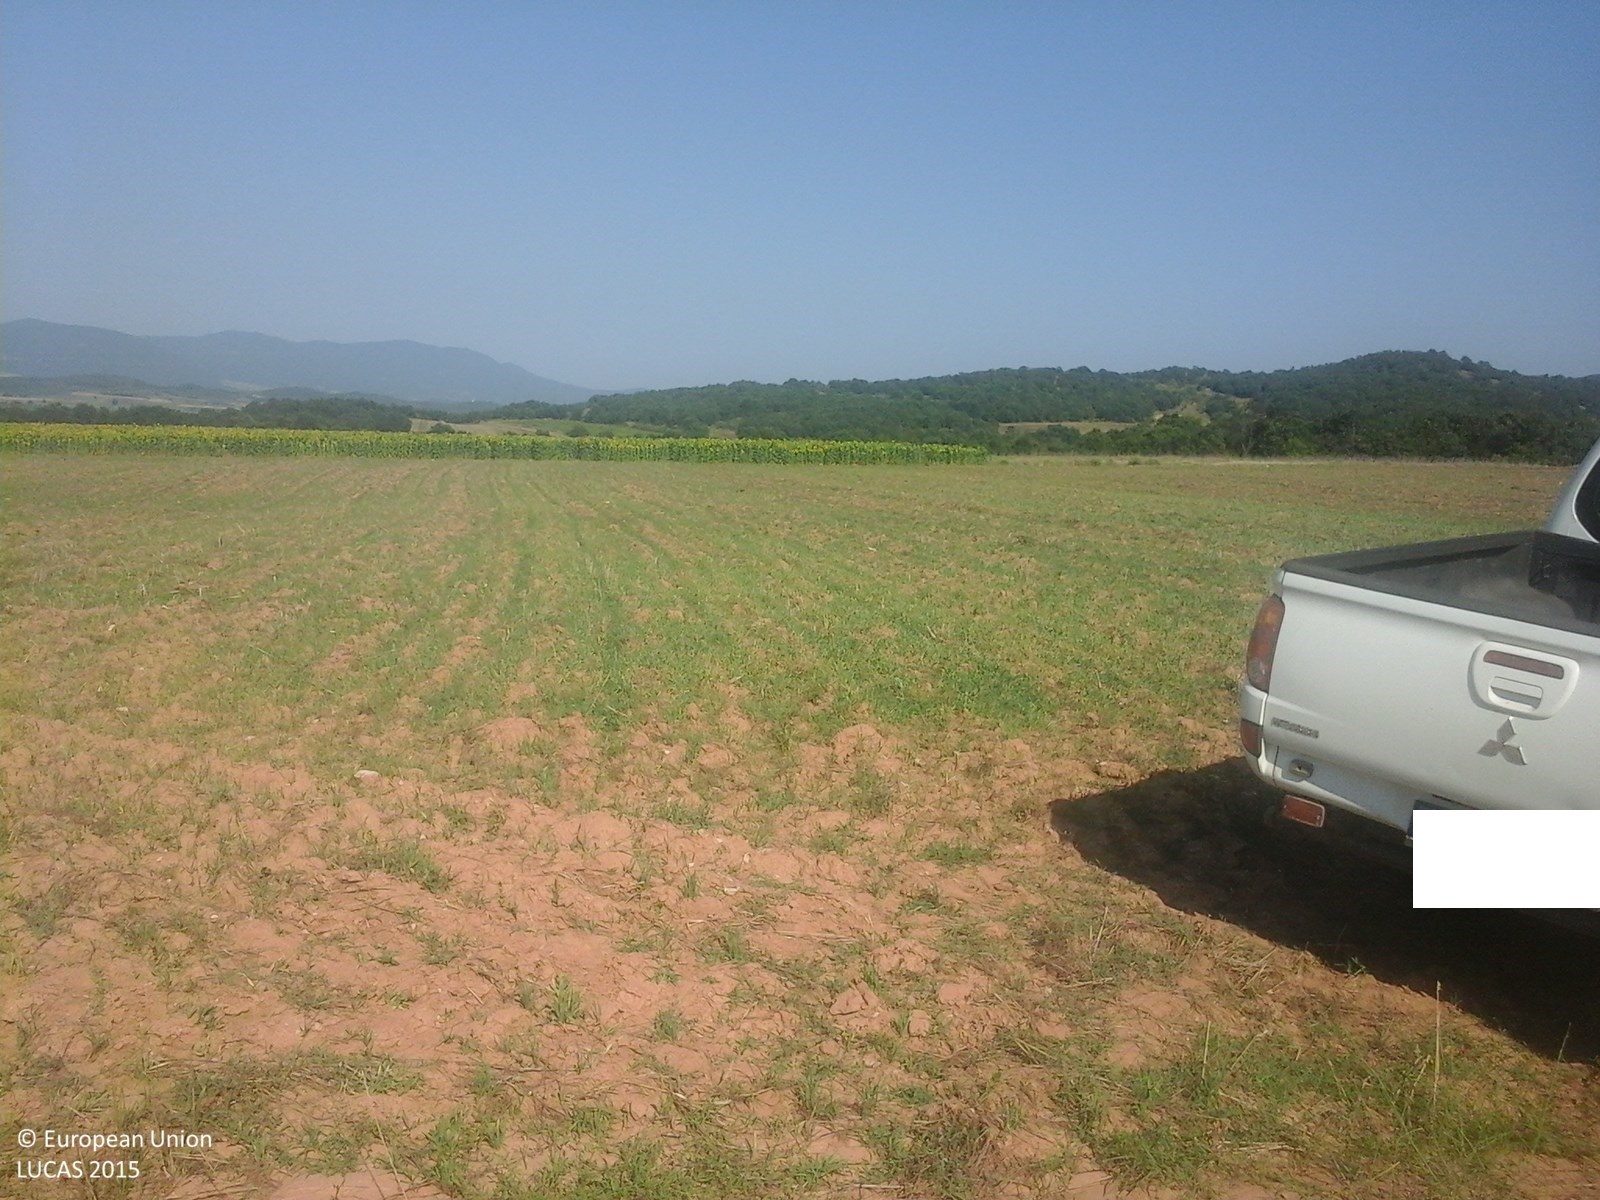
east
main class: Cropland
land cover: Sunflower
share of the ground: > 75 %
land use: Agriculture (excluding fallow land and kitchen gardens)
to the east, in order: Sunflower; Tracks; Common wheat; Sunflower
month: July
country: GR
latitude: 40.7696
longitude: 23.4138
